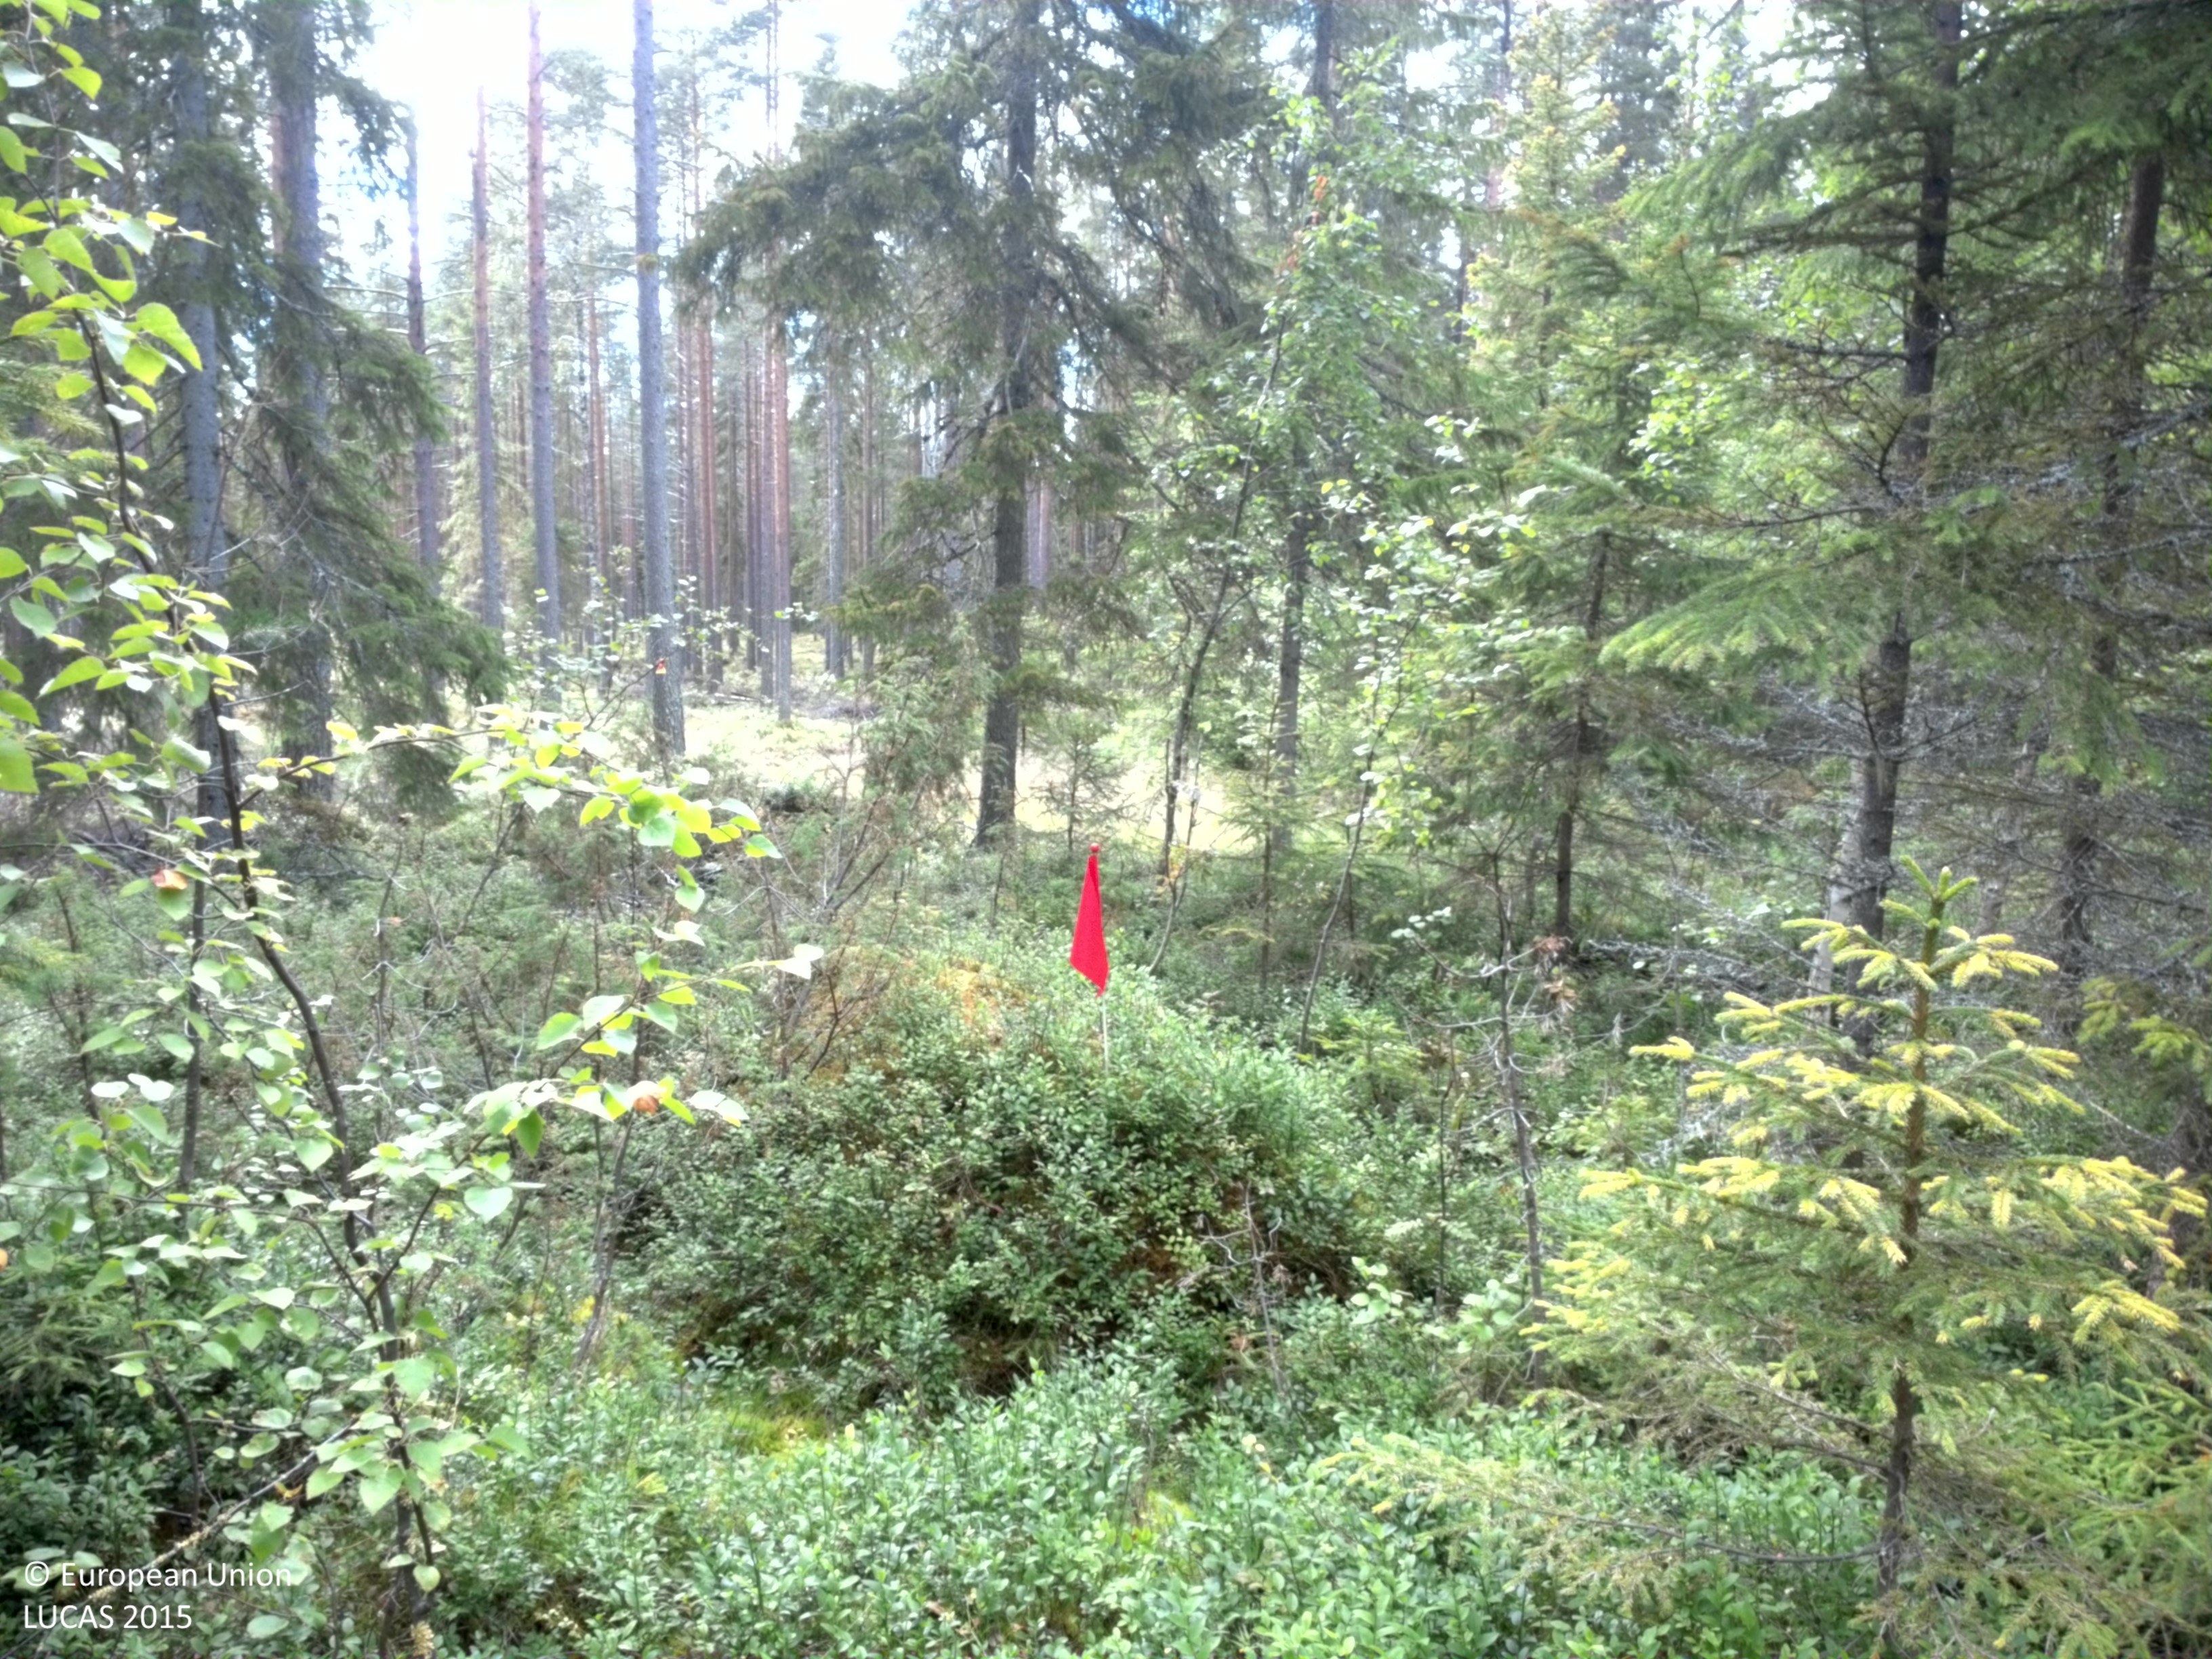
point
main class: Woodland
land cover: Other mixed woodland
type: boreal forest
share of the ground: 50 - 75 %
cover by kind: coniferous forest trees 45 %, shrubs 40 %, broadleaved forest trees 15 %
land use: Forestry
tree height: > 5 m
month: August
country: SE
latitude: 64.6263
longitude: 20.8754
